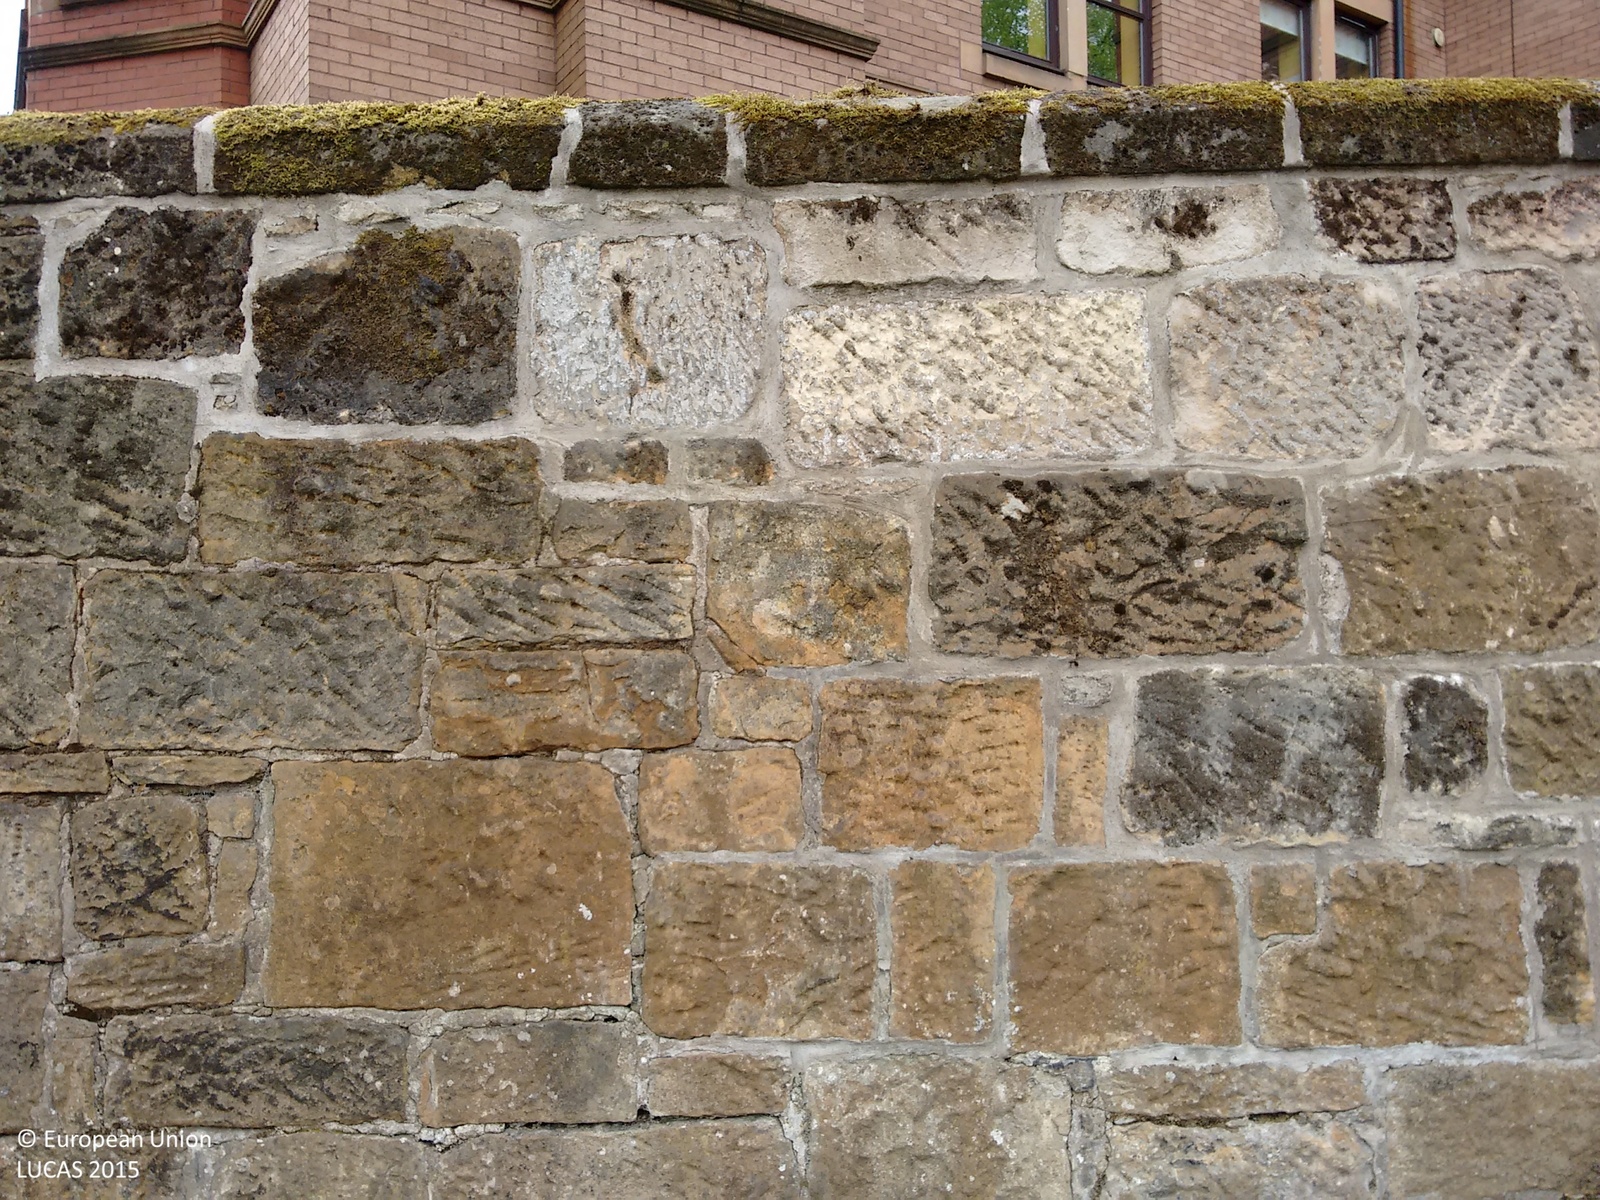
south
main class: Woodland
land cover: Broadleaved woodland
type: exotic forest
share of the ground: > 75 %
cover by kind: broadleaved forest trees 100 %
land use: Residential
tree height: > 5 m
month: May
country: GB
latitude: 55.8746
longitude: -4.3031
